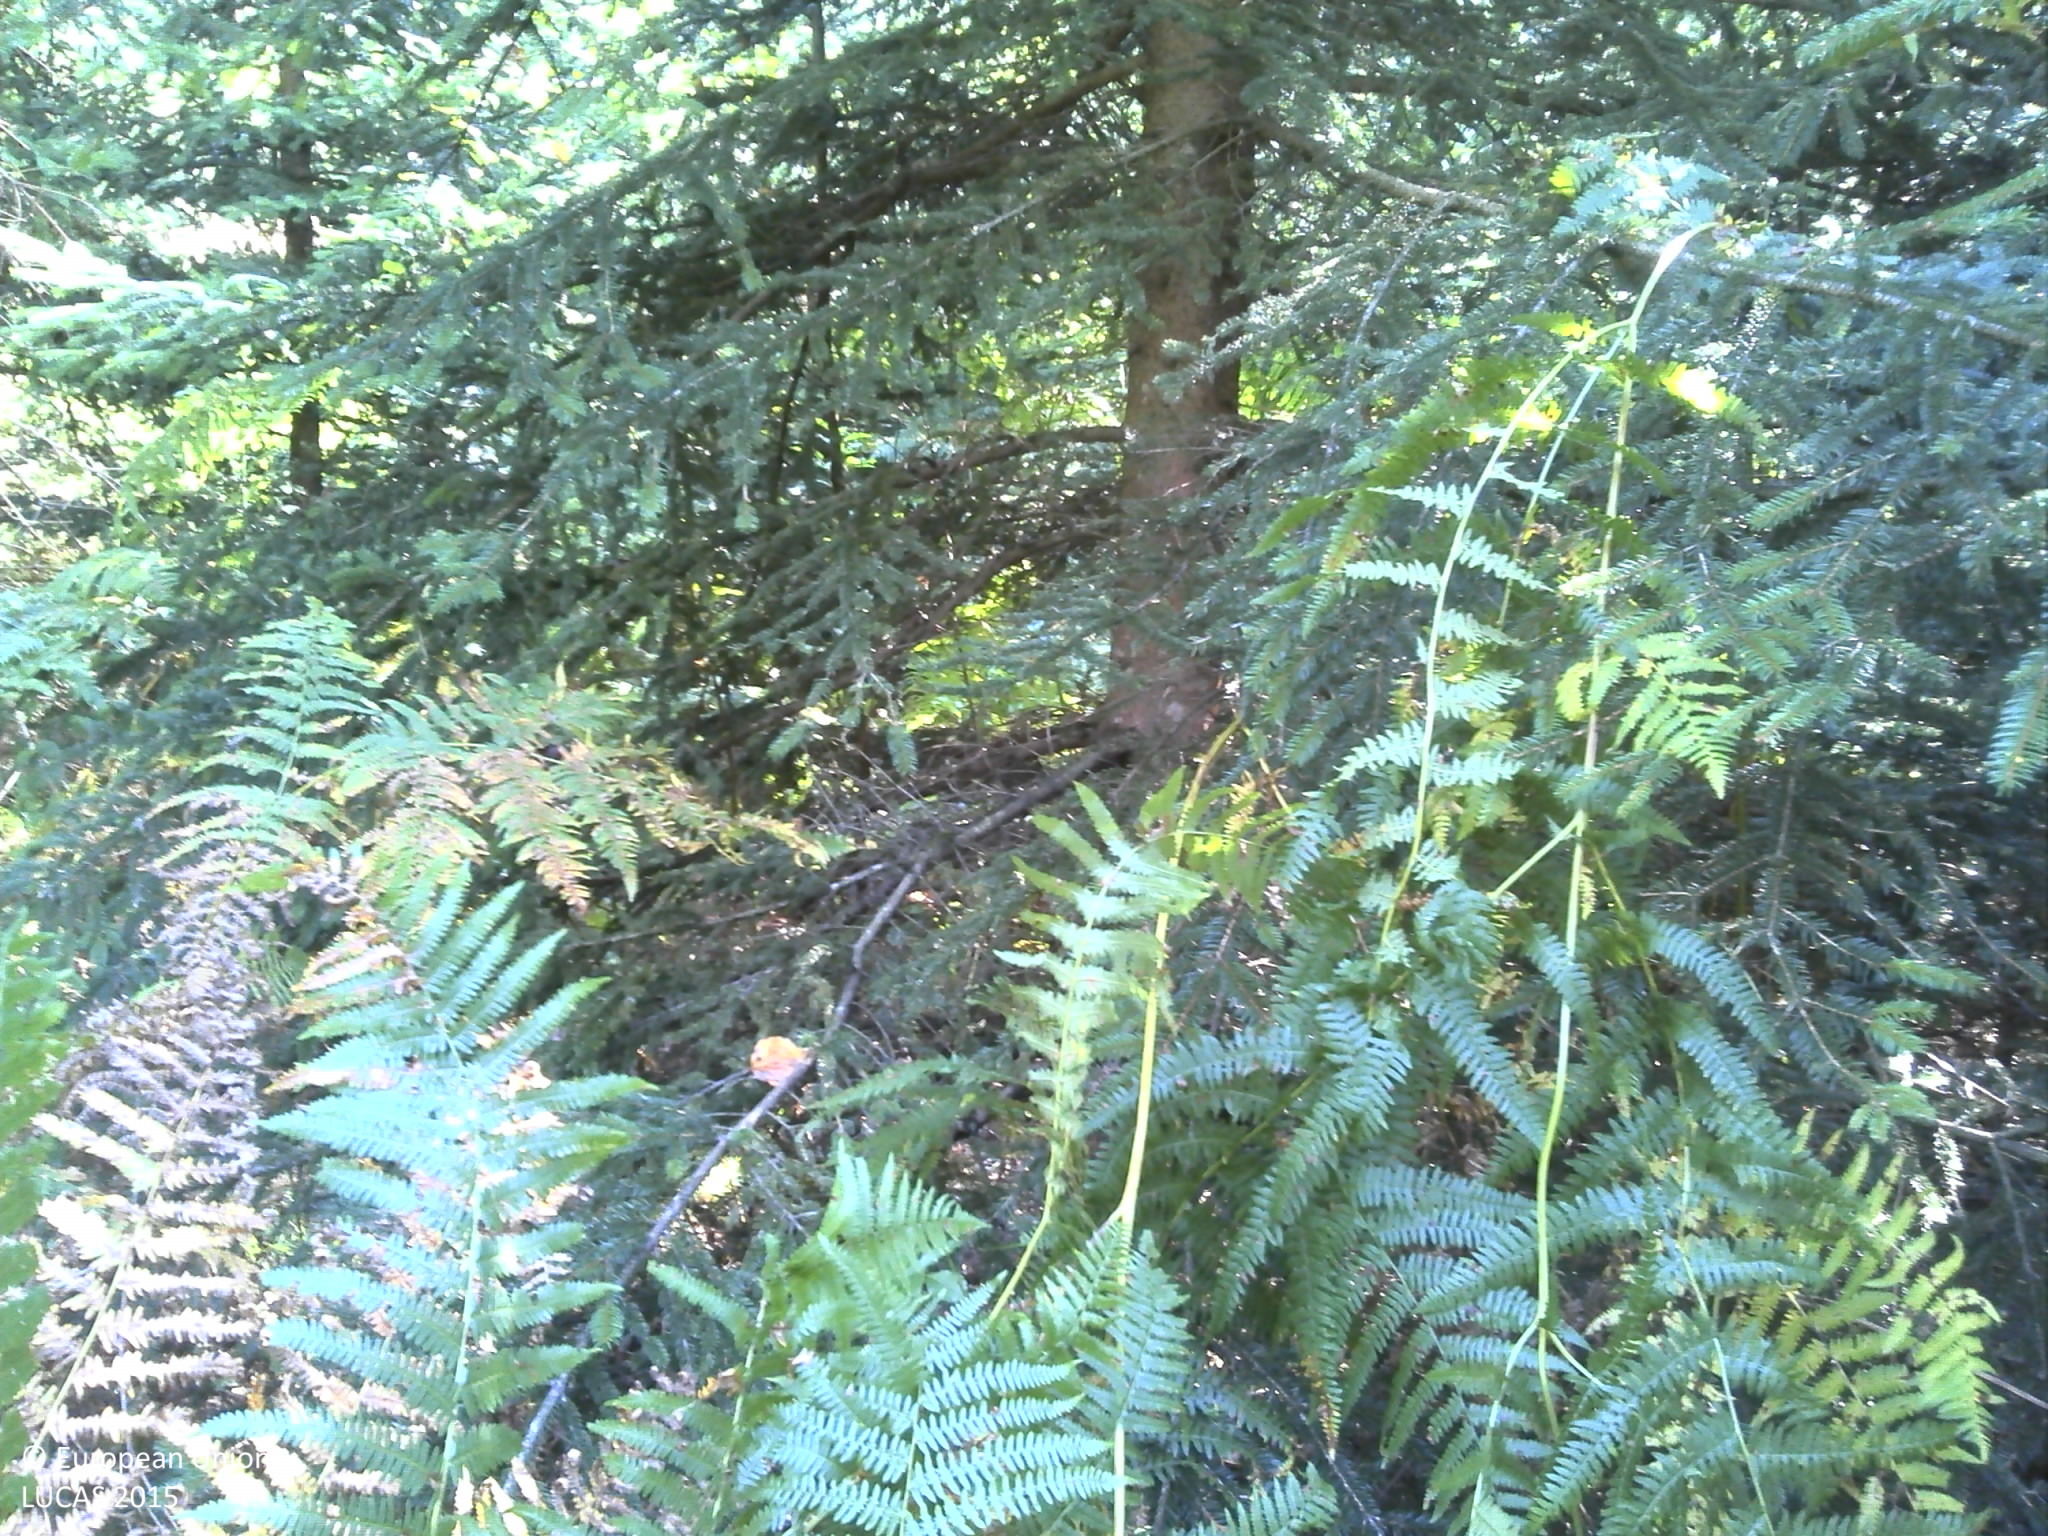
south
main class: Woodland
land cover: Spruce dominated coniferous woodland
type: coniferous forest of the mediterranean region
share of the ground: > 75 %
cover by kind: coniferous forest trees 100 %
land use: Forestry
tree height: > 5 m
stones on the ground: < 10 %
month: September
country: HR
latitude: 45.3177
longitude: 15.2894
